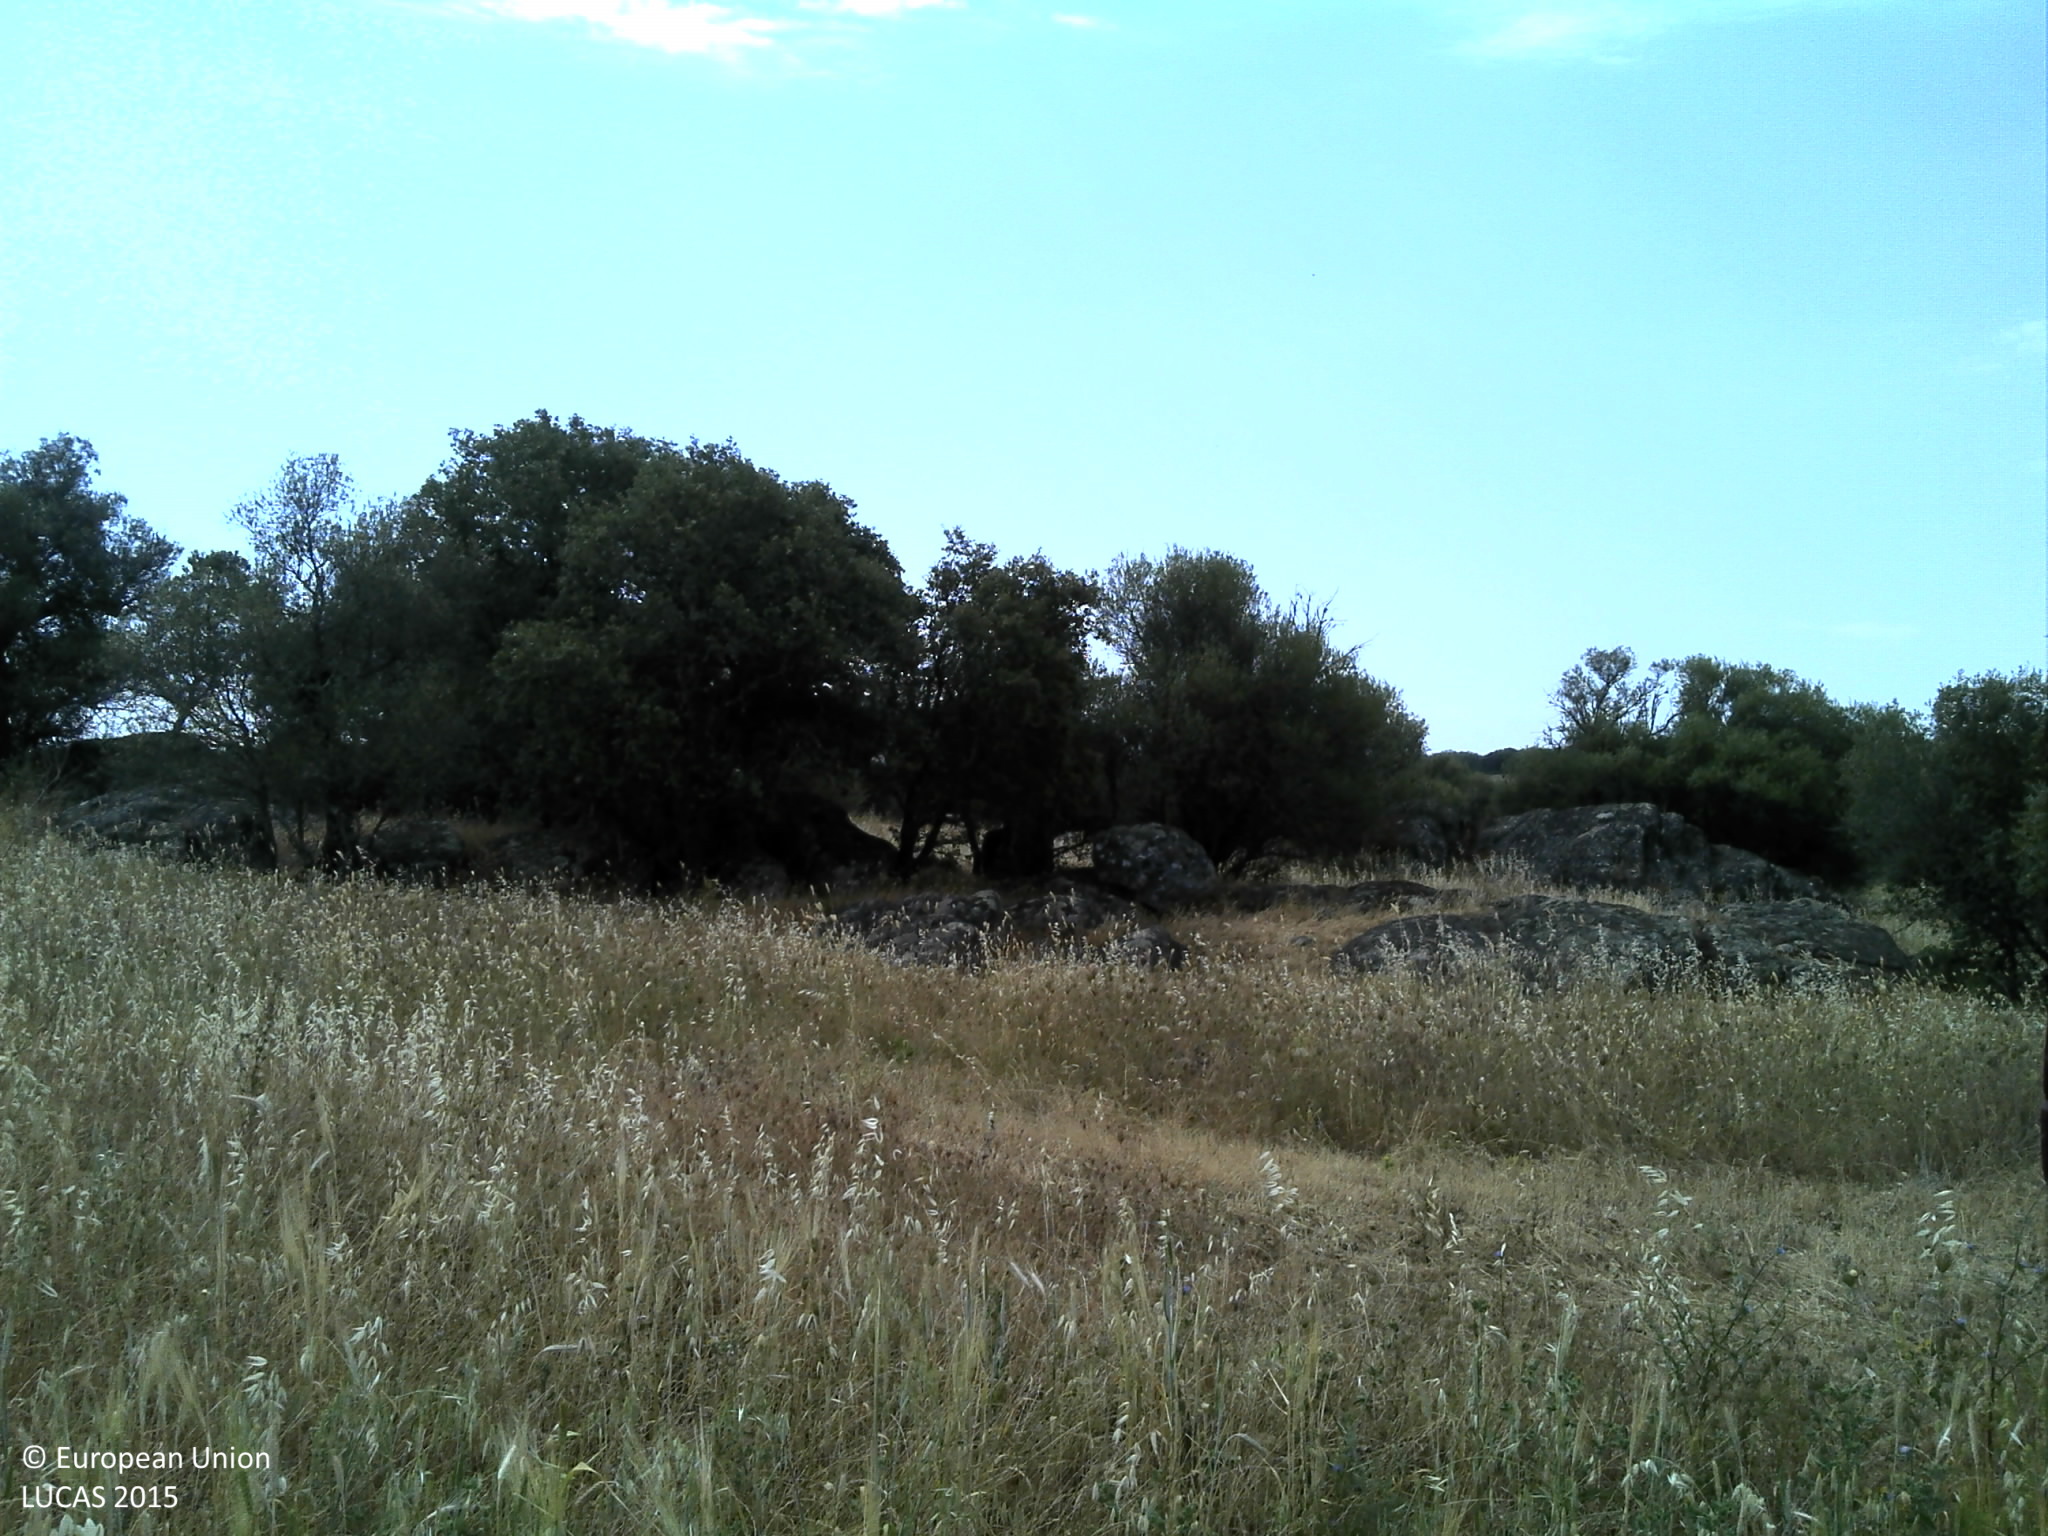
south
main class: Cropland
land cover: Triticale
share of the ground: > 75 %
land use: Agriculture (excluding fallow land and kitchen gardens)
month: May
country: PT
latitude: 38.8828
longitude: -7.9017
